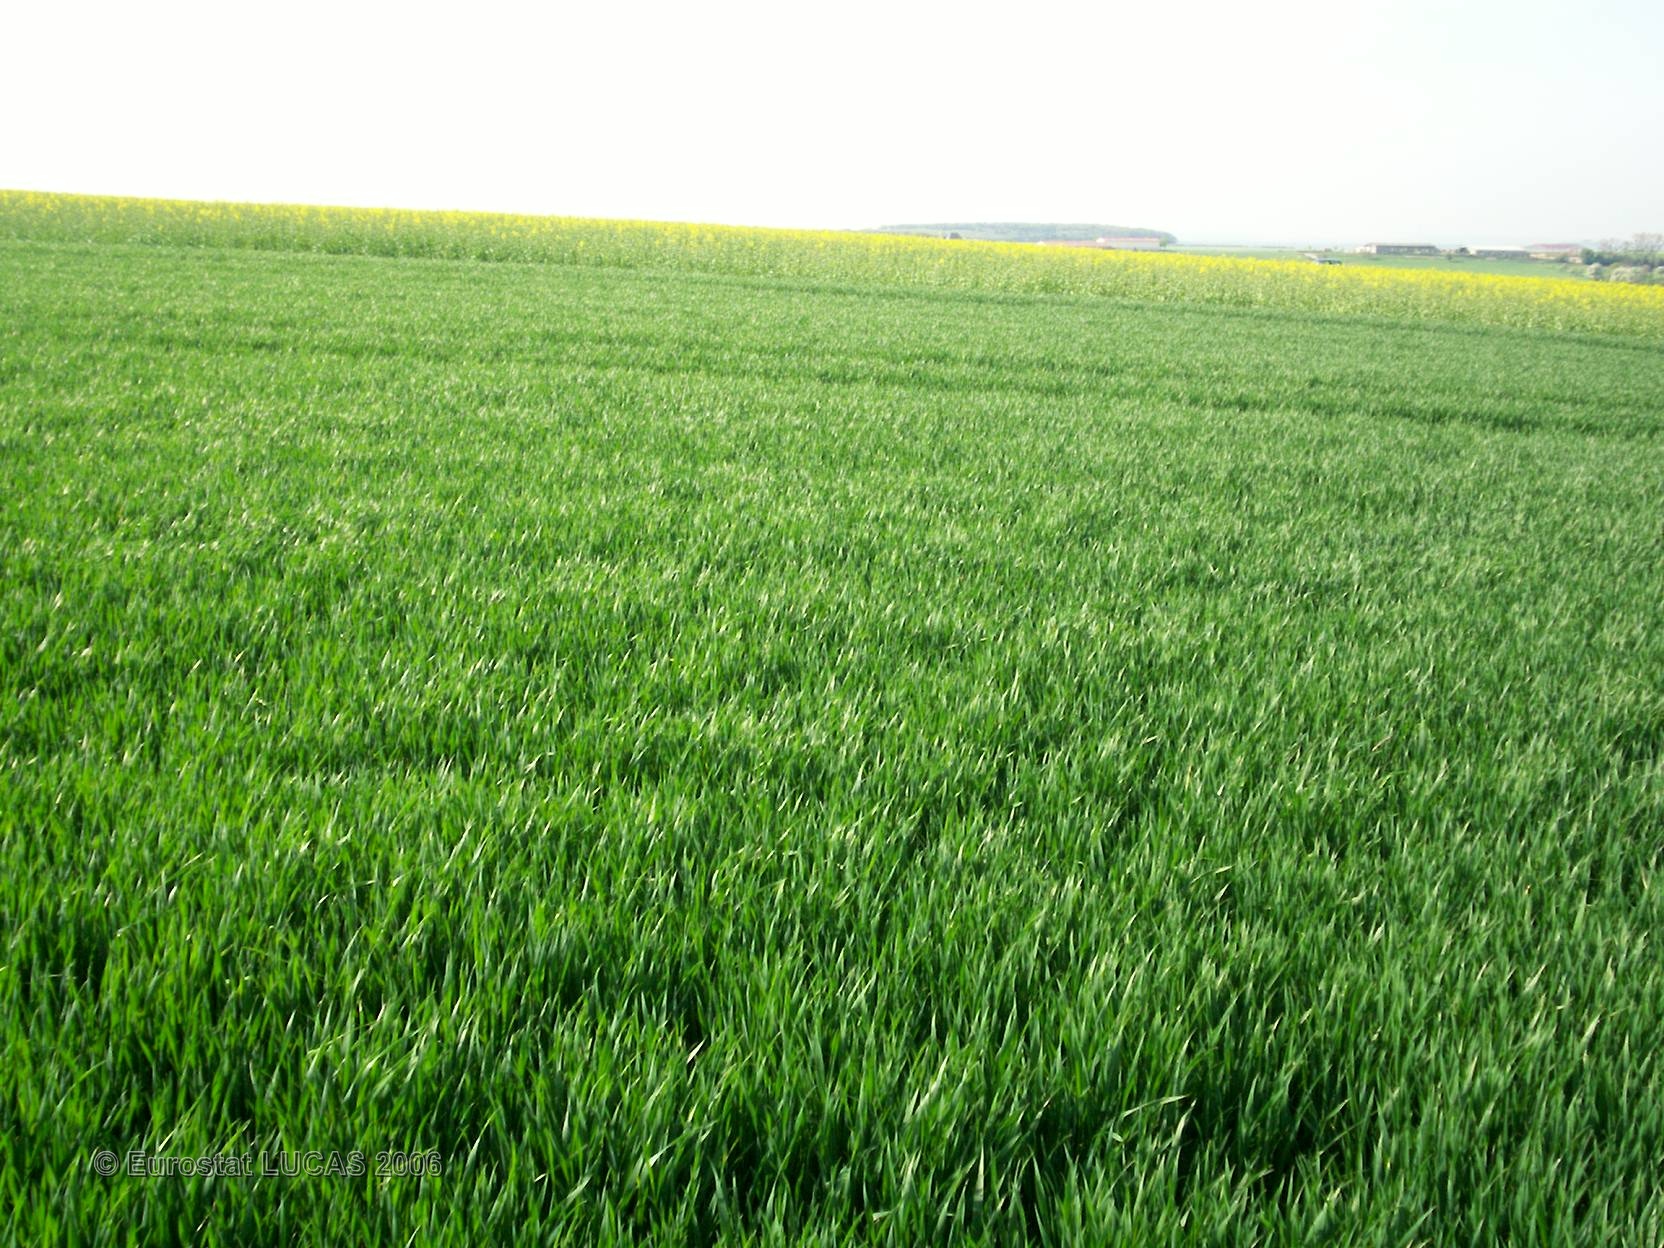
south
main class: Cropland
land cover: Common wheat
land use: Agriculture (excluding fallow land and kitchen gardens)
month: May
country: FR
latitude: 49.1406
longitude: 6.5046
